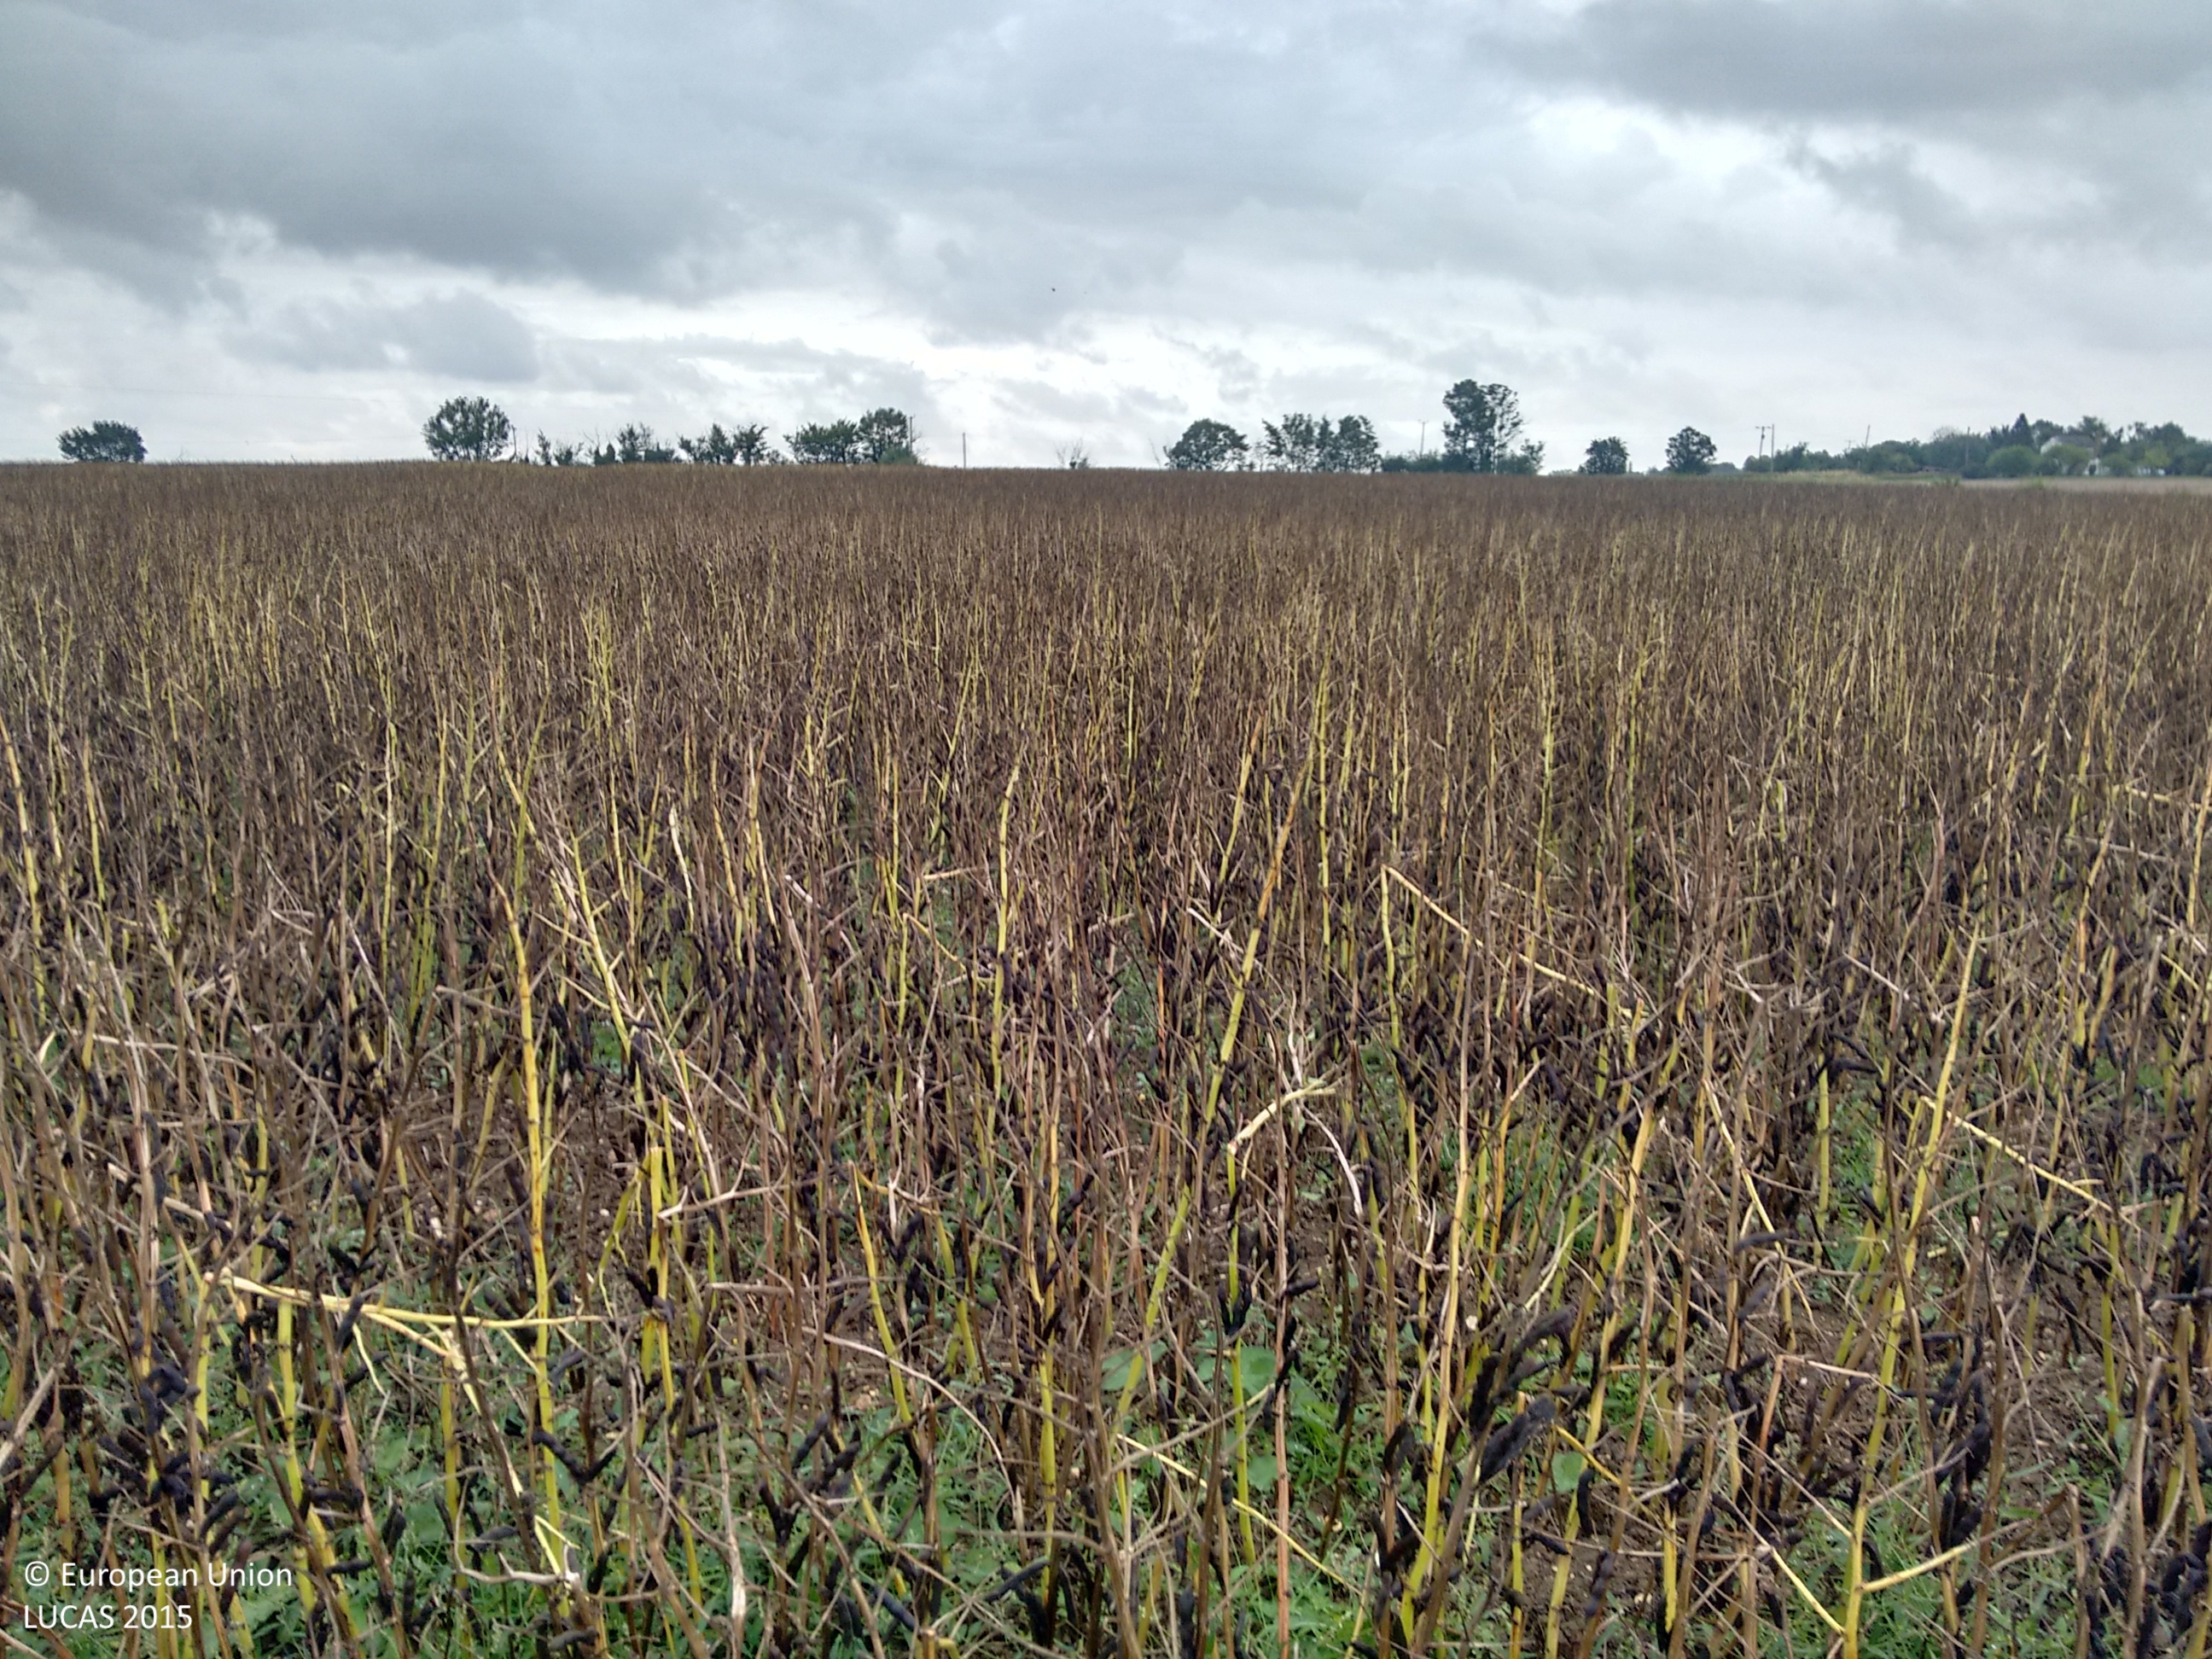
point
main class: Cropland
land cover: Dry pulses
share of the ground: > 75 %
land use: Agriculture (excluding fallow land and kitchen gardens)
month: August
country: GB
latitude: 52.0863
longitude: 0.5008
